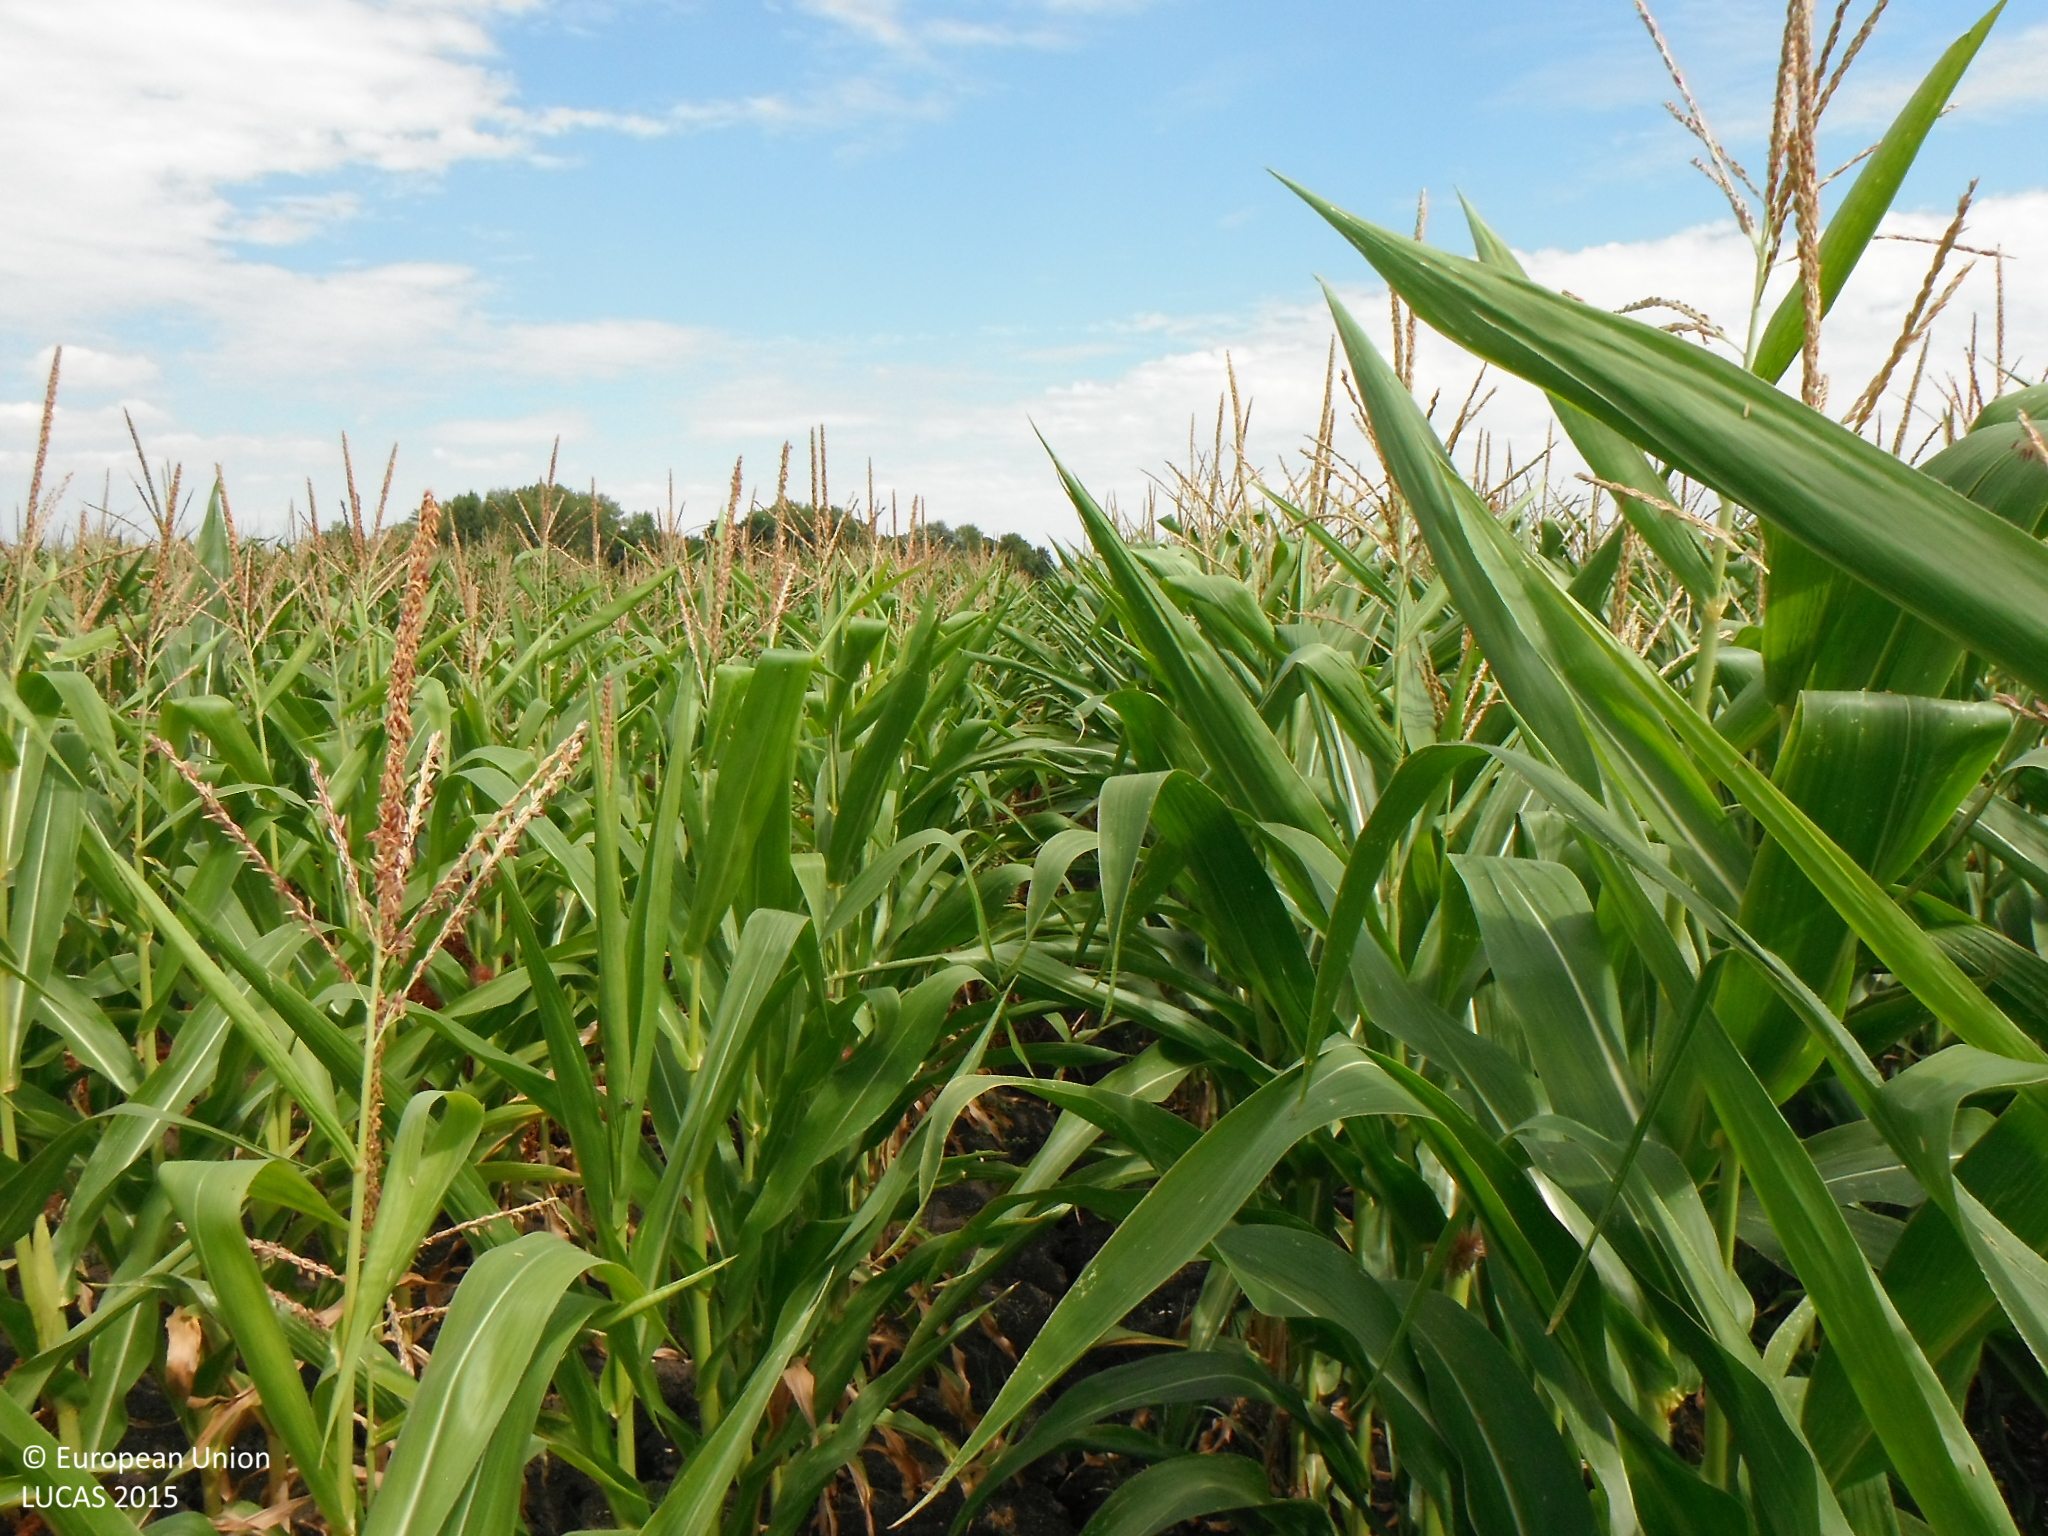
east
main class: Cropland
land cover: Maize
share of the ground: > 75 %
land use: Agriculture (excluding fallow land and kitchen gardens)
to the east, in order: Maize
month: July
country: SK
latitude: 48.1151
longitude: 18.2212
